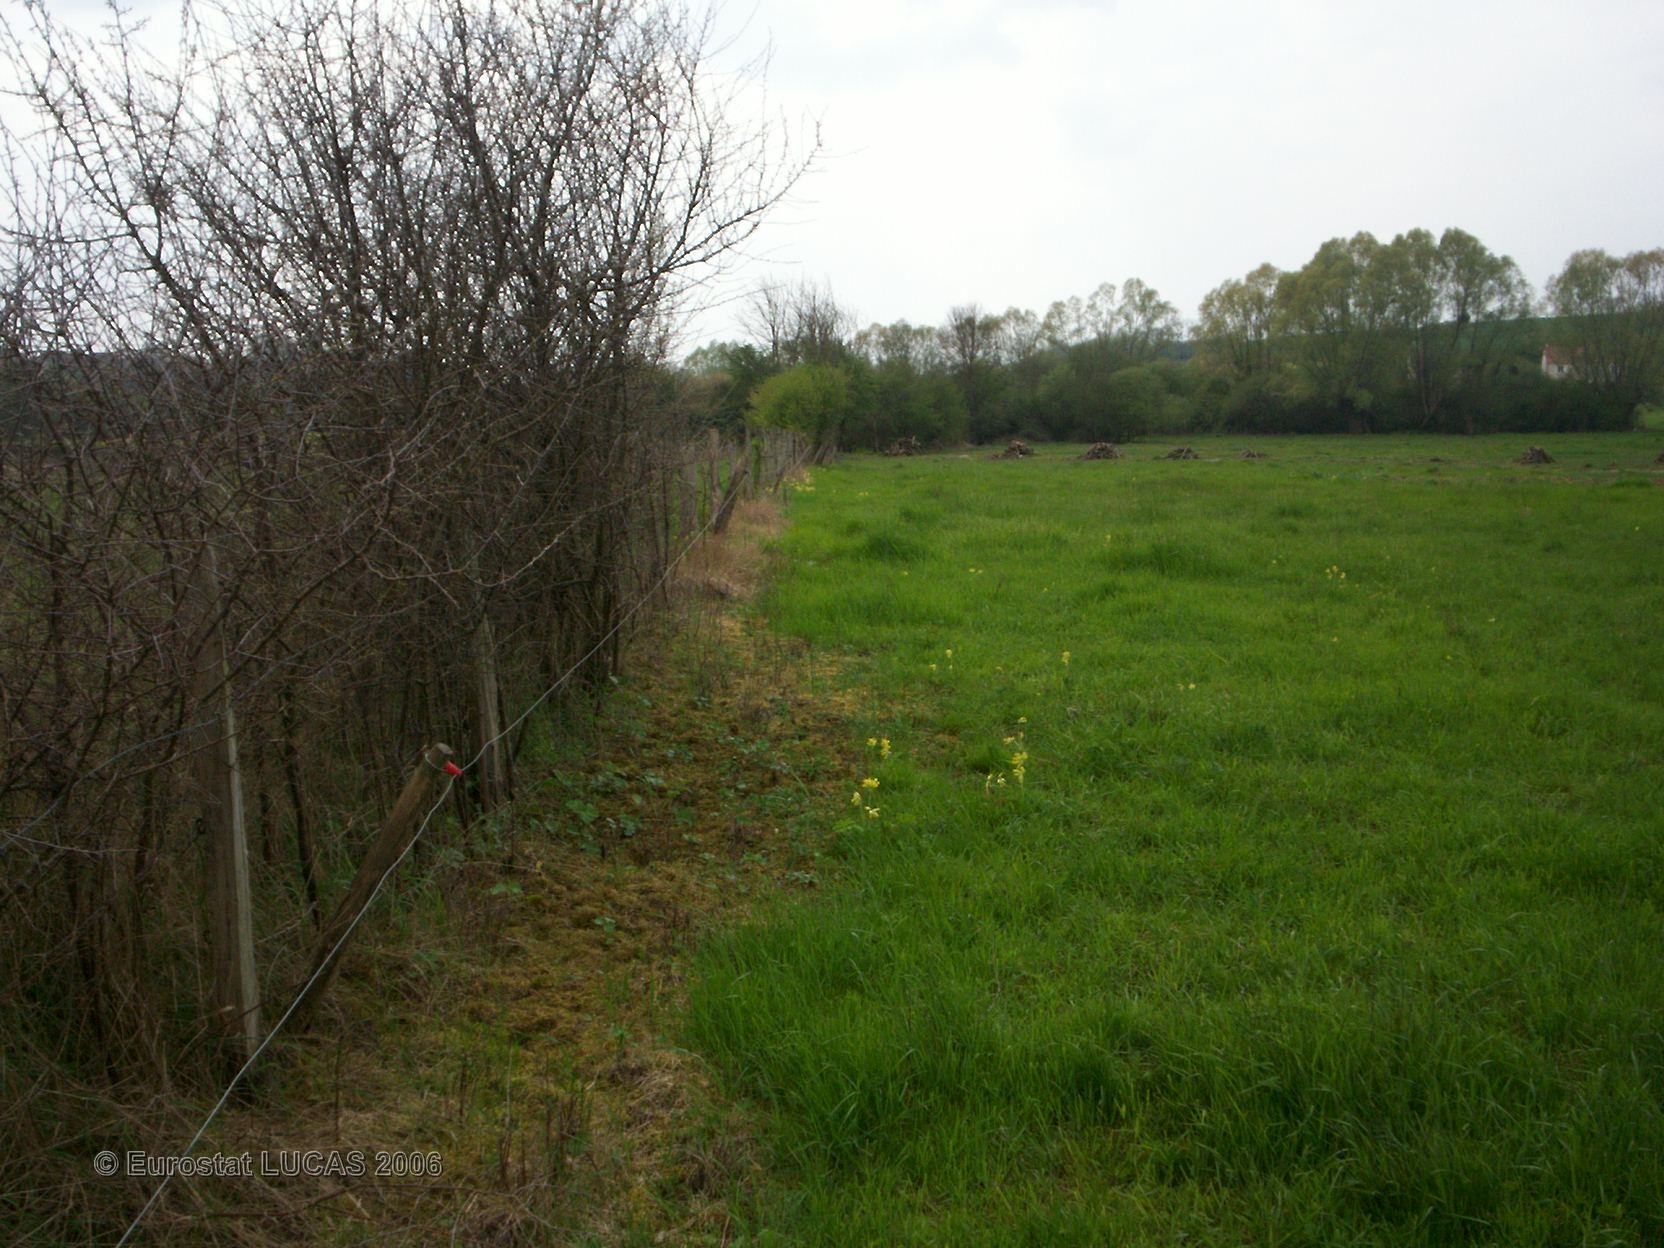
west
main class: Grassland
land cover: Grassland with sparse tree/shrub cover
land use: Agriculture (excluding fallow land and kitchen gardens)
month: April
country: FR
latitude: 47.0831
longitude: 3.0542
